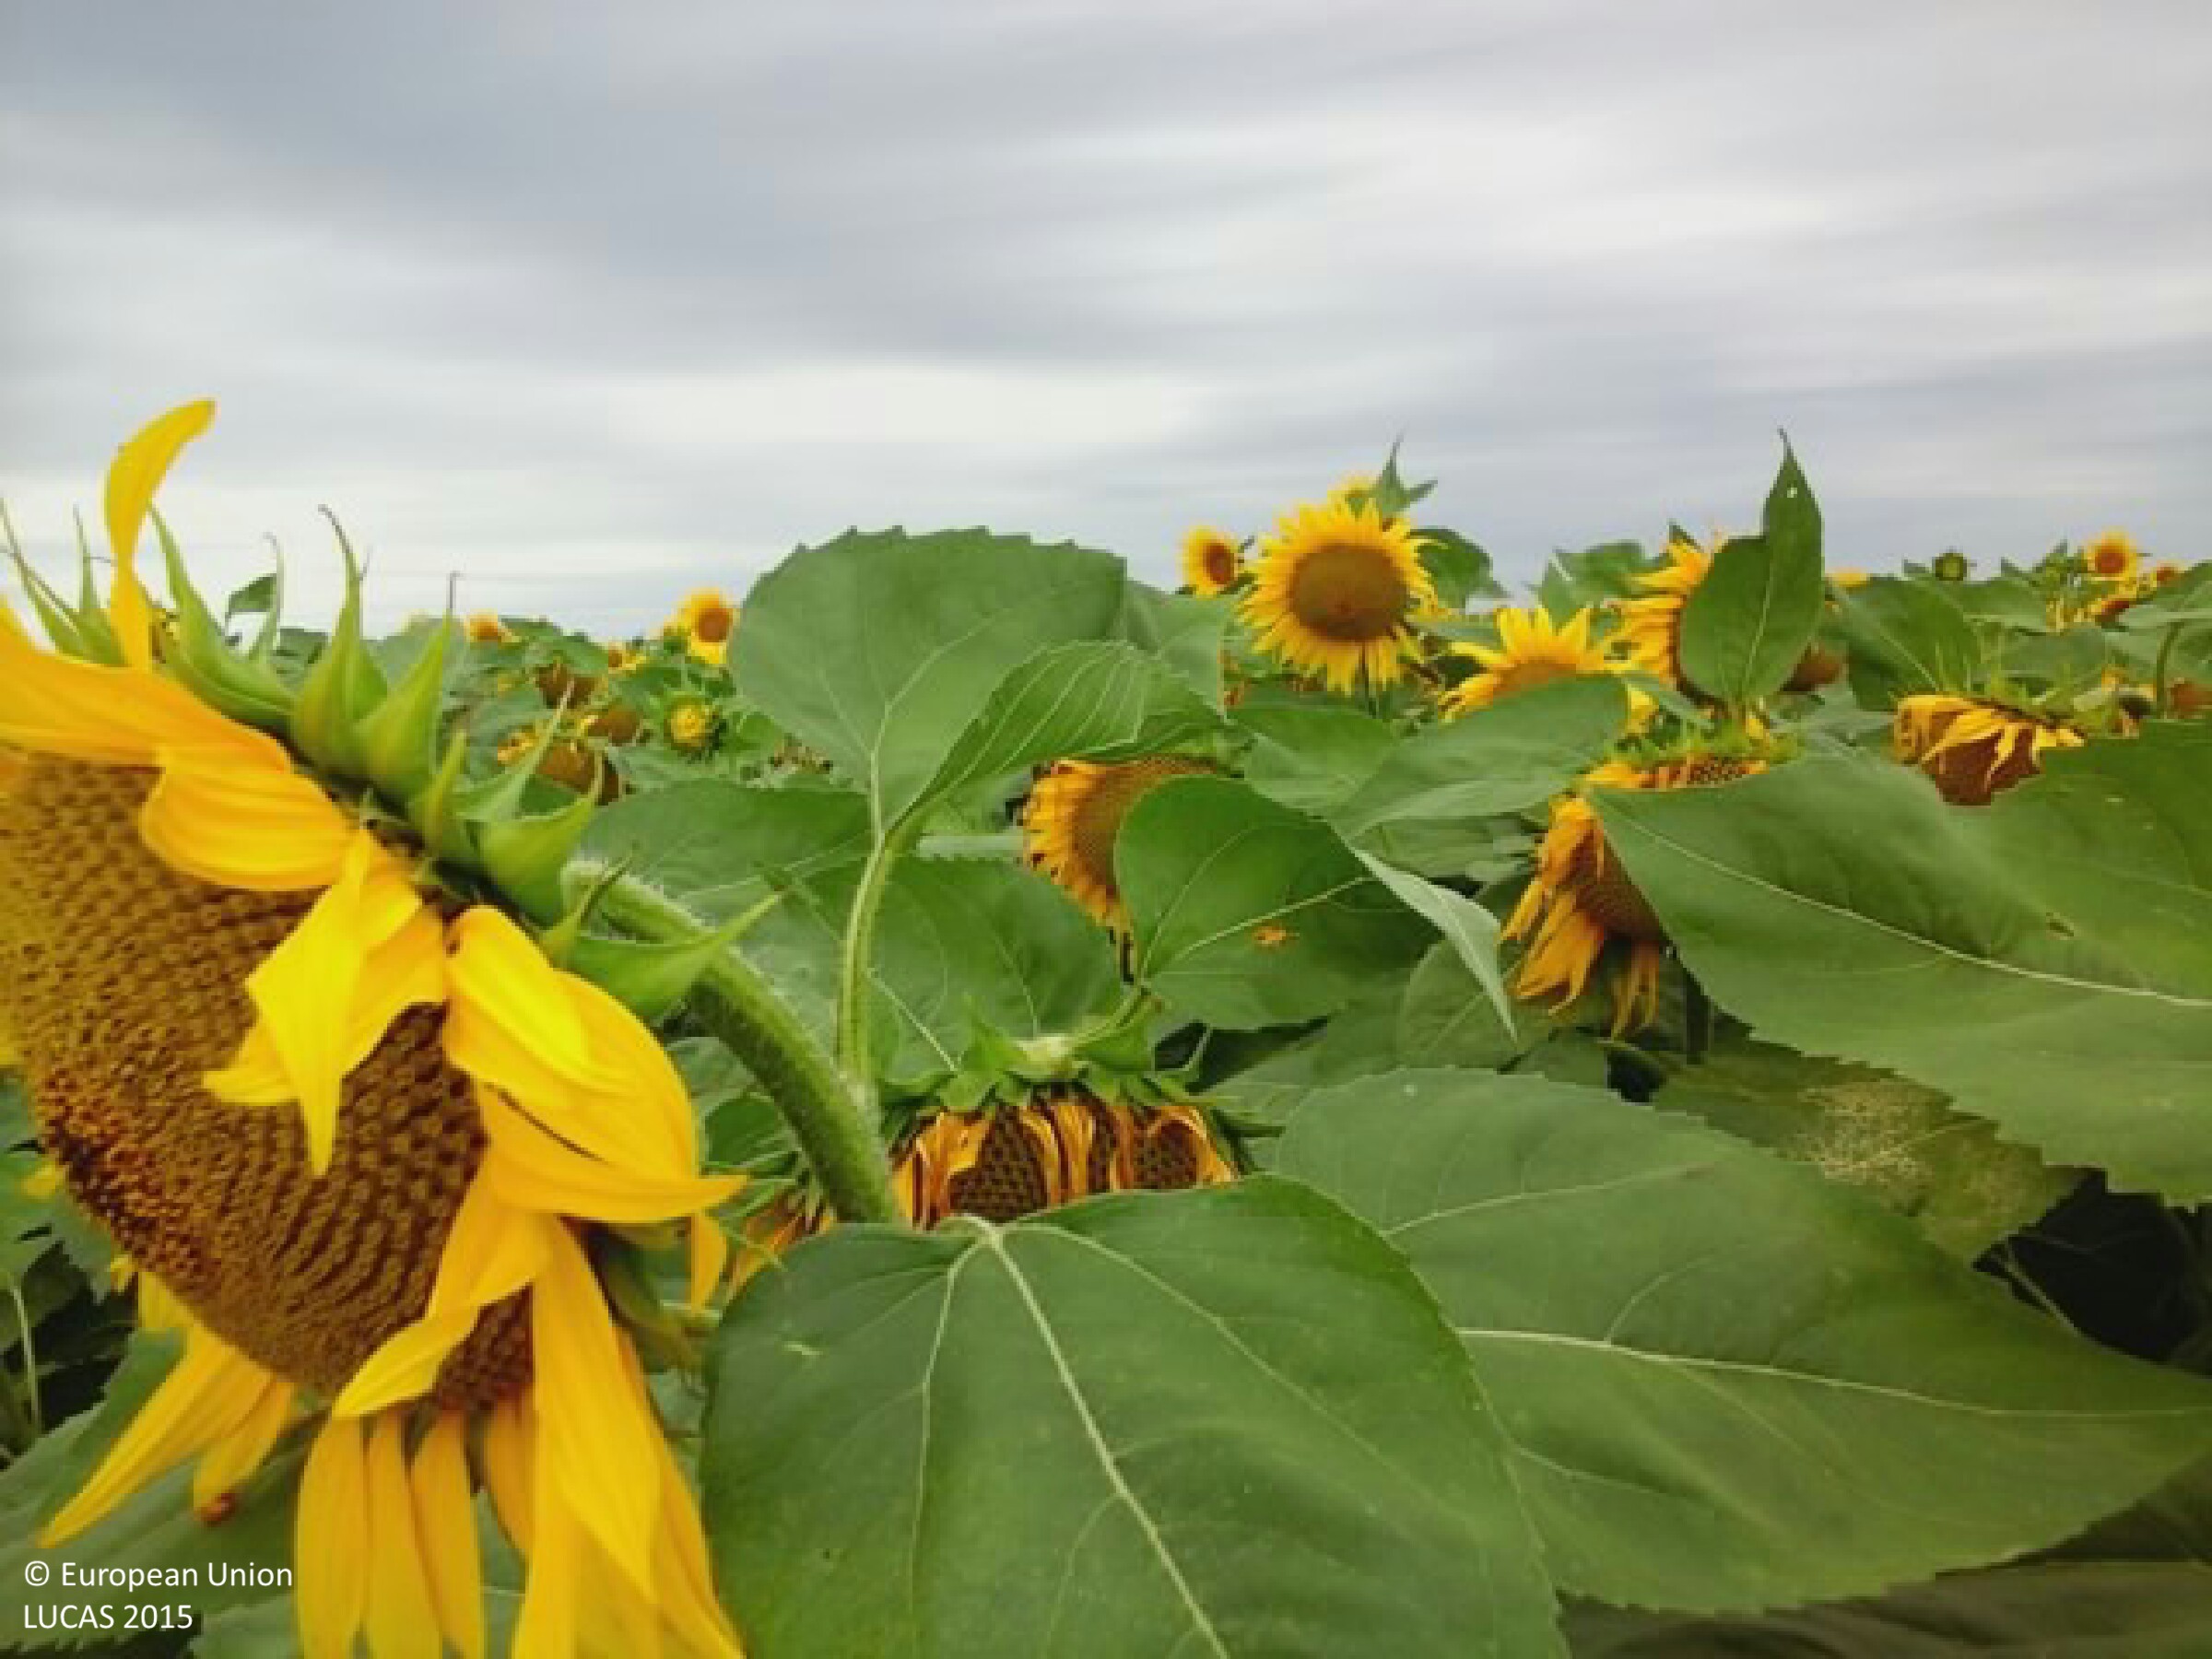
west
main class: Cropland
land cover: Sunflower
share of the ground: > 75 %
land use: Agriculture (excluding fallow land and kitchen gardens)
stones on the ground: < 10 %
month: July
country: HU
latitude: 46.2384
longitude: 19.4699
